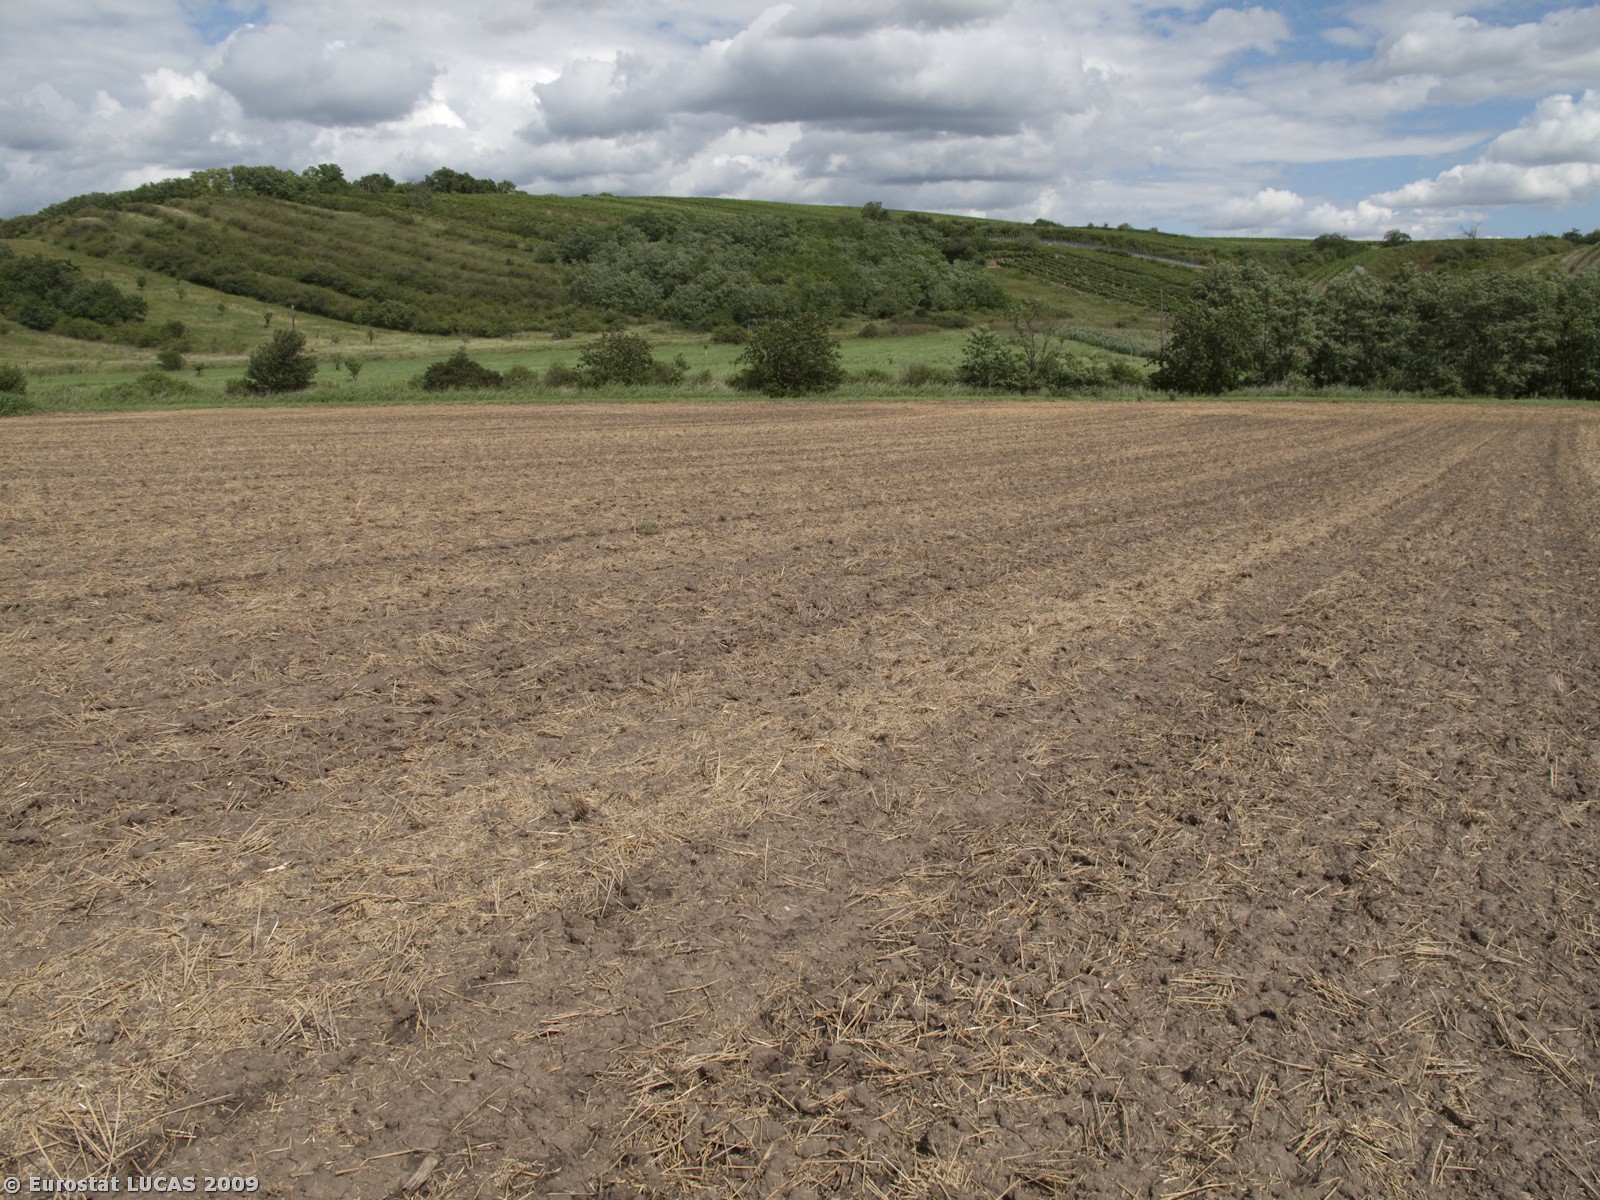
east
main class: Cropland
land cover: Common wheat
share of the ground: < 10 %
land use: Agriculture (excluding fallow land and kitchen gardens)
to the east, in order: Common wheat; Grass margins; Inland marshes; Rivers and streams; Inland marshes; Tracks; Grass margins; Inland marshes; Electric lines; Inland marshes; Grassland without tree/shrub cover; Grassland with sparse tree/shrub cover; Tracks; Grassland with sparse tree/shrub cover
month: July
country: AT
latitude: 48.7441
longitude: 16.0291
